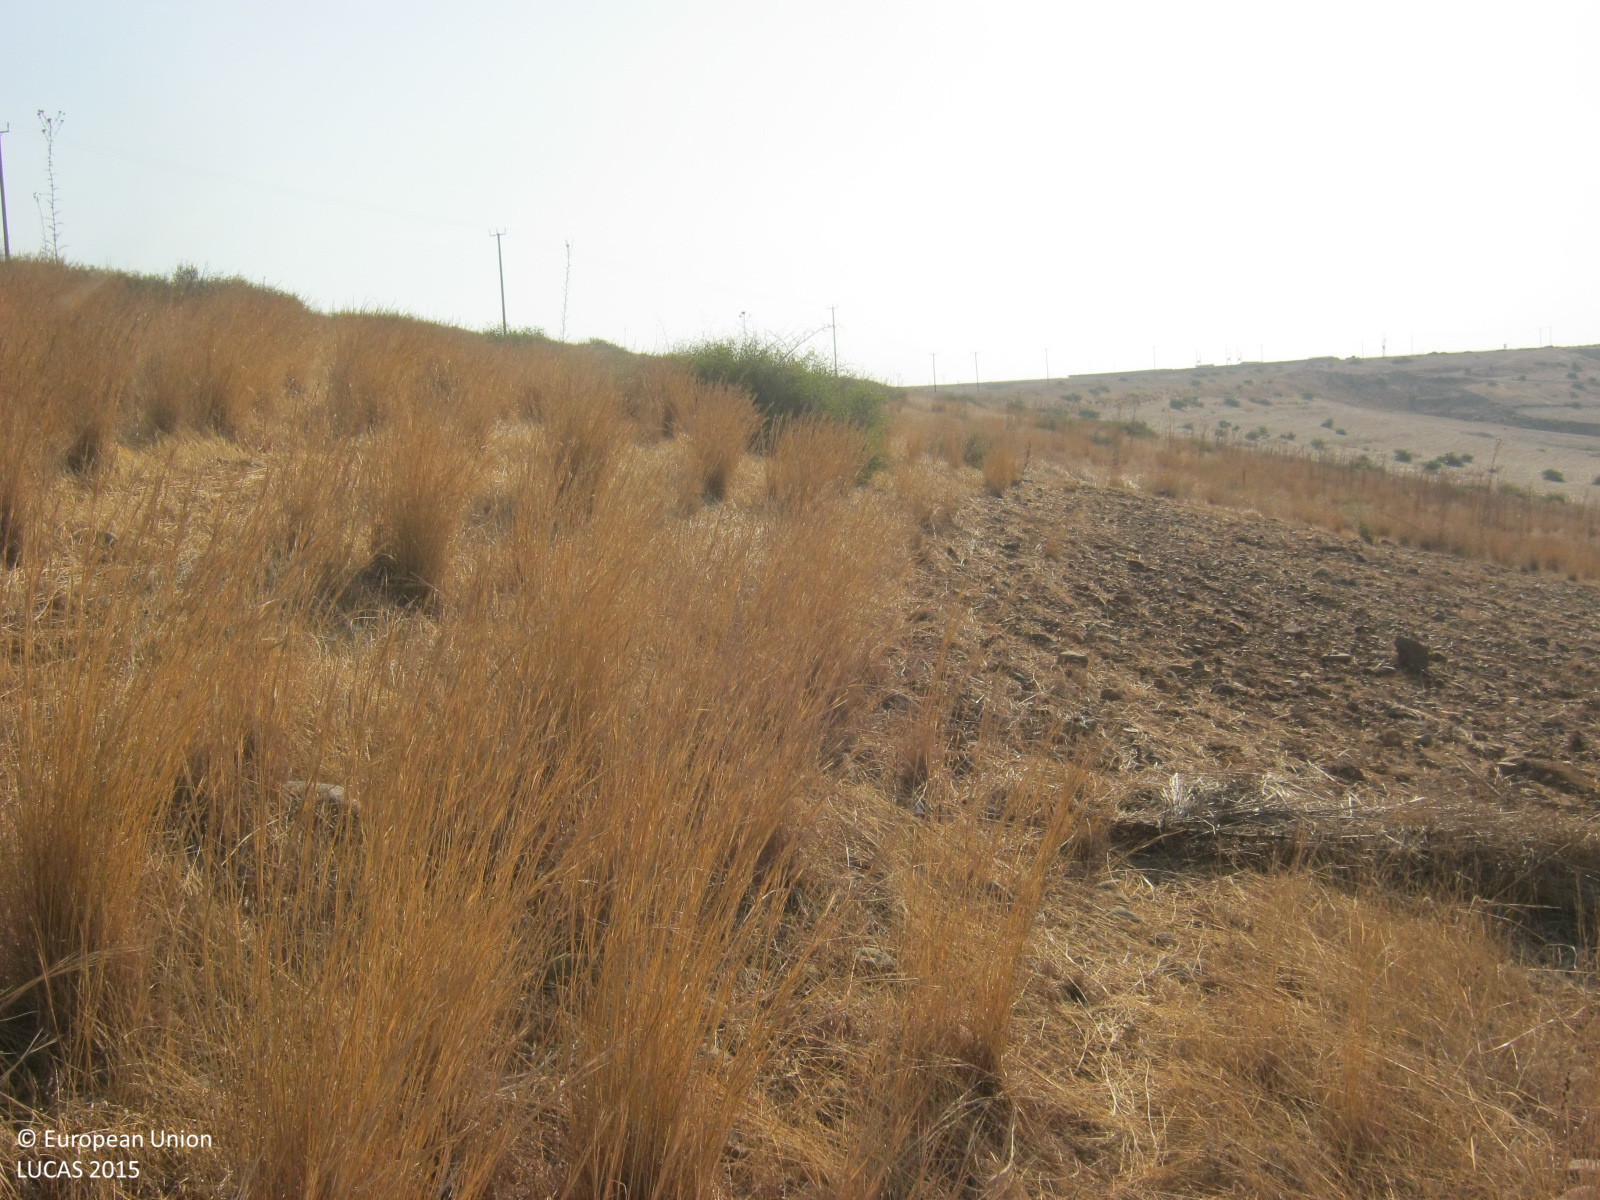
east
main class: Shrubland
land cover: Shrubland without tree cover
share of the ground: 10 - 25 %
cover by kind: herbaceous plants 80 %, shrubs 15 %, unconsolidated bare surface 5 %
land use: Semi-natural and natural areas not in use
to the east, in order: Shrubland without tree cover; Other bare soil; Shrubland without tree cover; Tracks; Shrubland without tree cover; Electric lines; Shrubland without tree cover; Paved roads, cycling and walking lanes; Grass margins
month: September
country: CY
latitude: 35.0995
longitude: 33.0518
